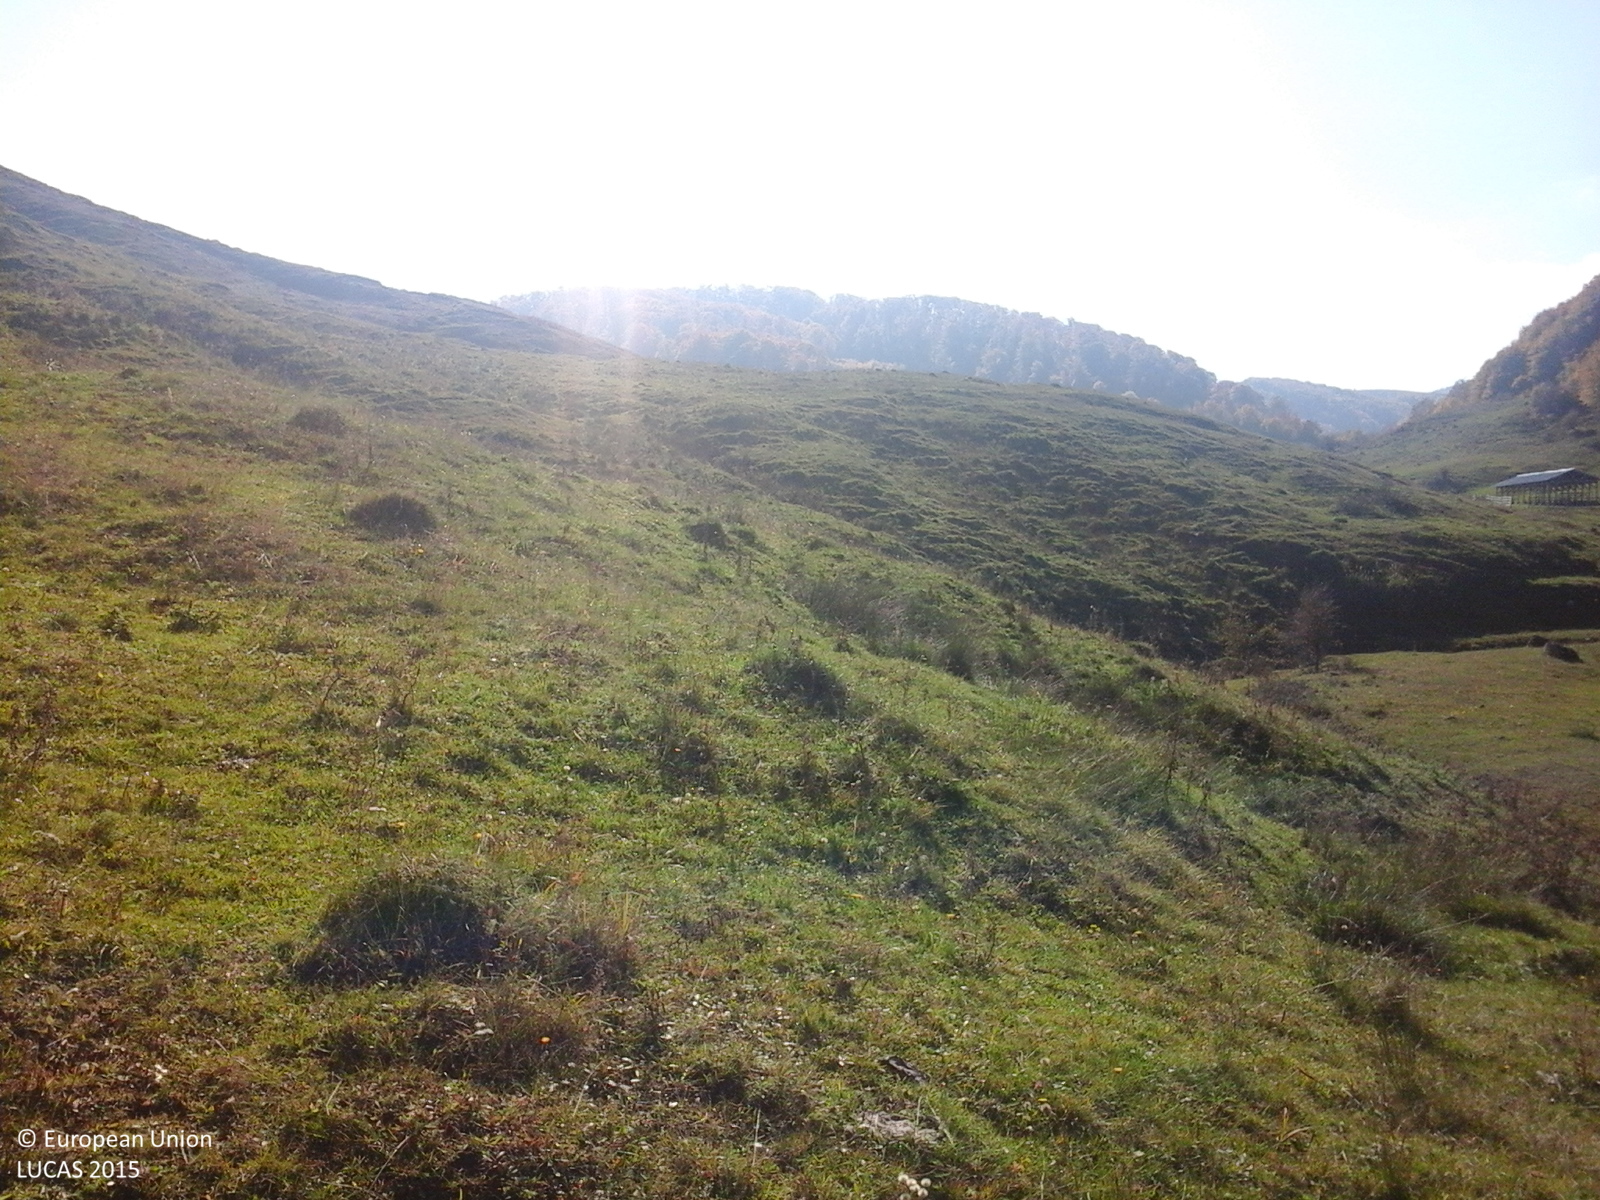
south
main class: Grassland
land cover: Grassland without tree/shrub cover
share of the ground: > 75 %
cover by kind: herbaceous plants 100 %
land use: Agriculture (excluding fallow land and kitchen gardens)
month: October
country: RO
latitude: 46.0311
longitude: 26.7384
